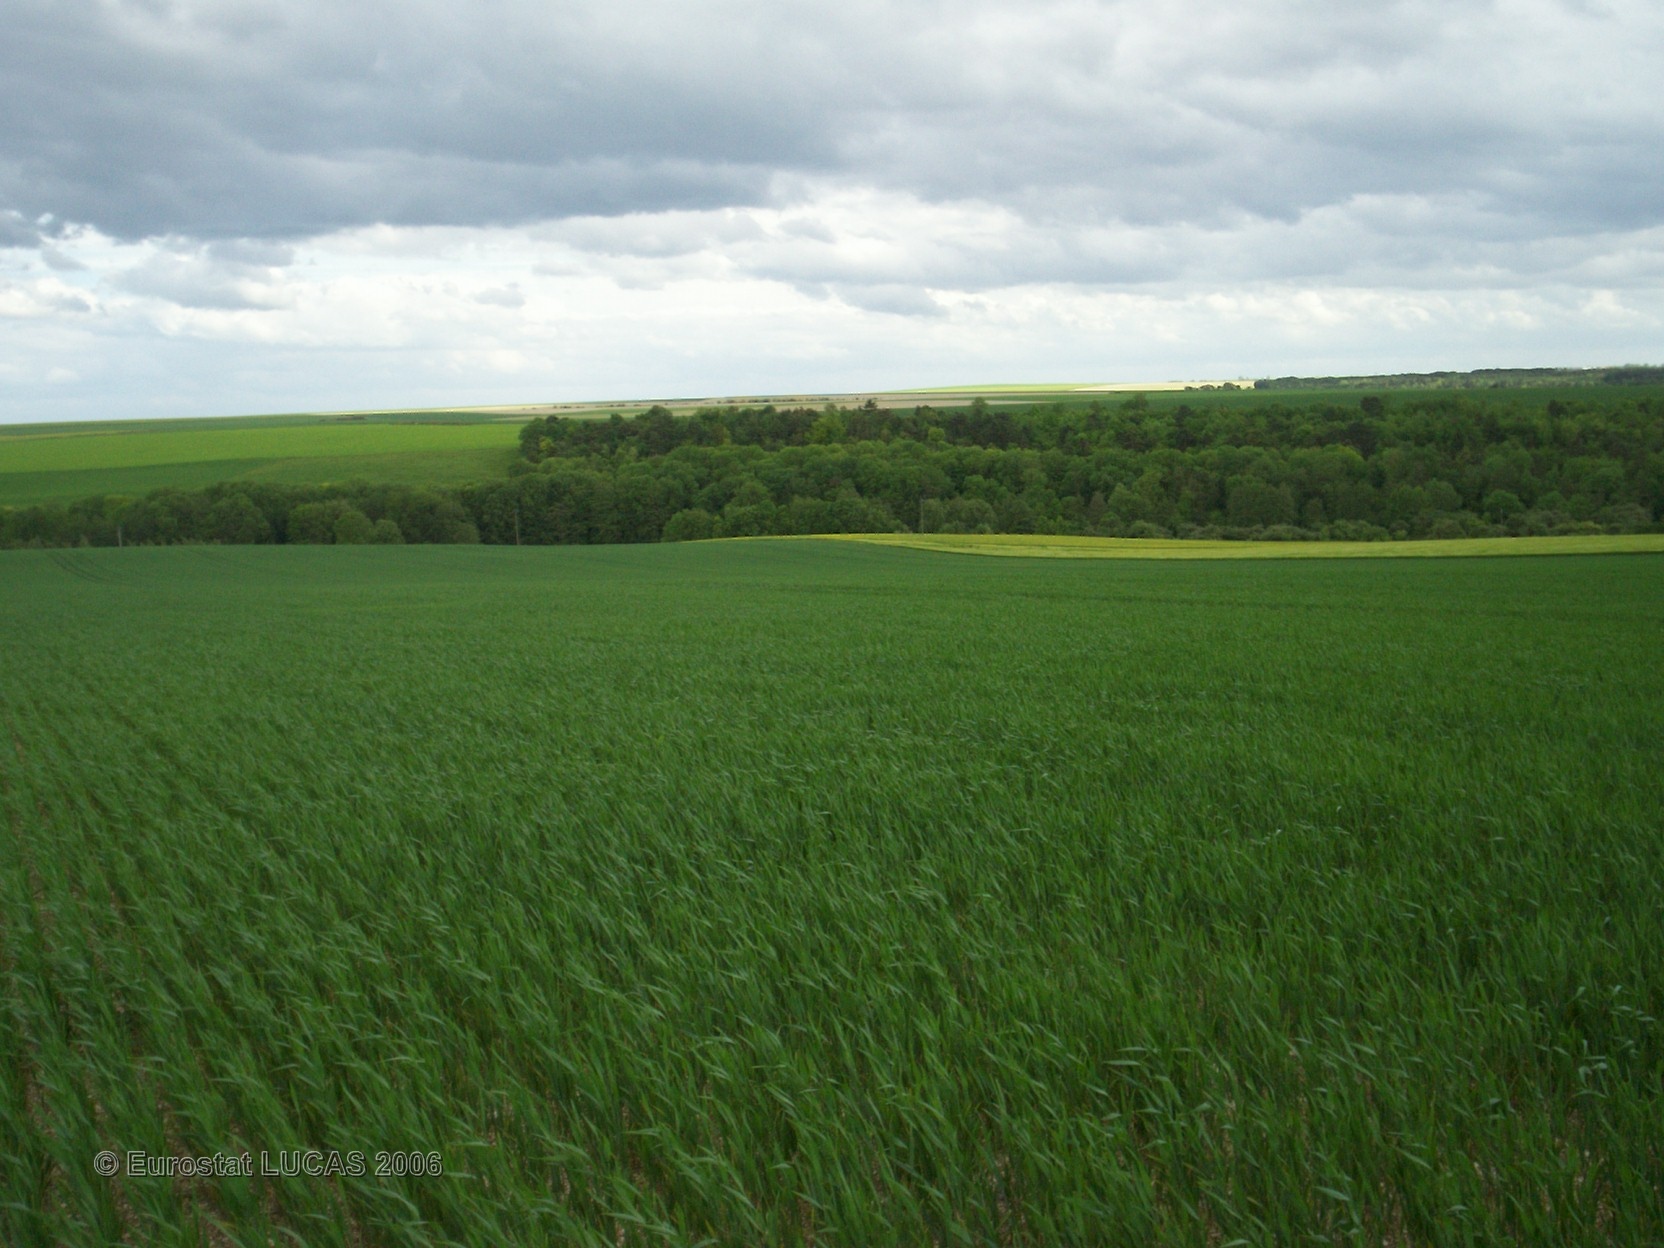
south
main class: Cropland
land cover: Common wheat
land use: Agriculture (excluding fallow land and kitchen gardens)
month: May
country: FR
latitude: 49.3527
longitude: 4.5863
